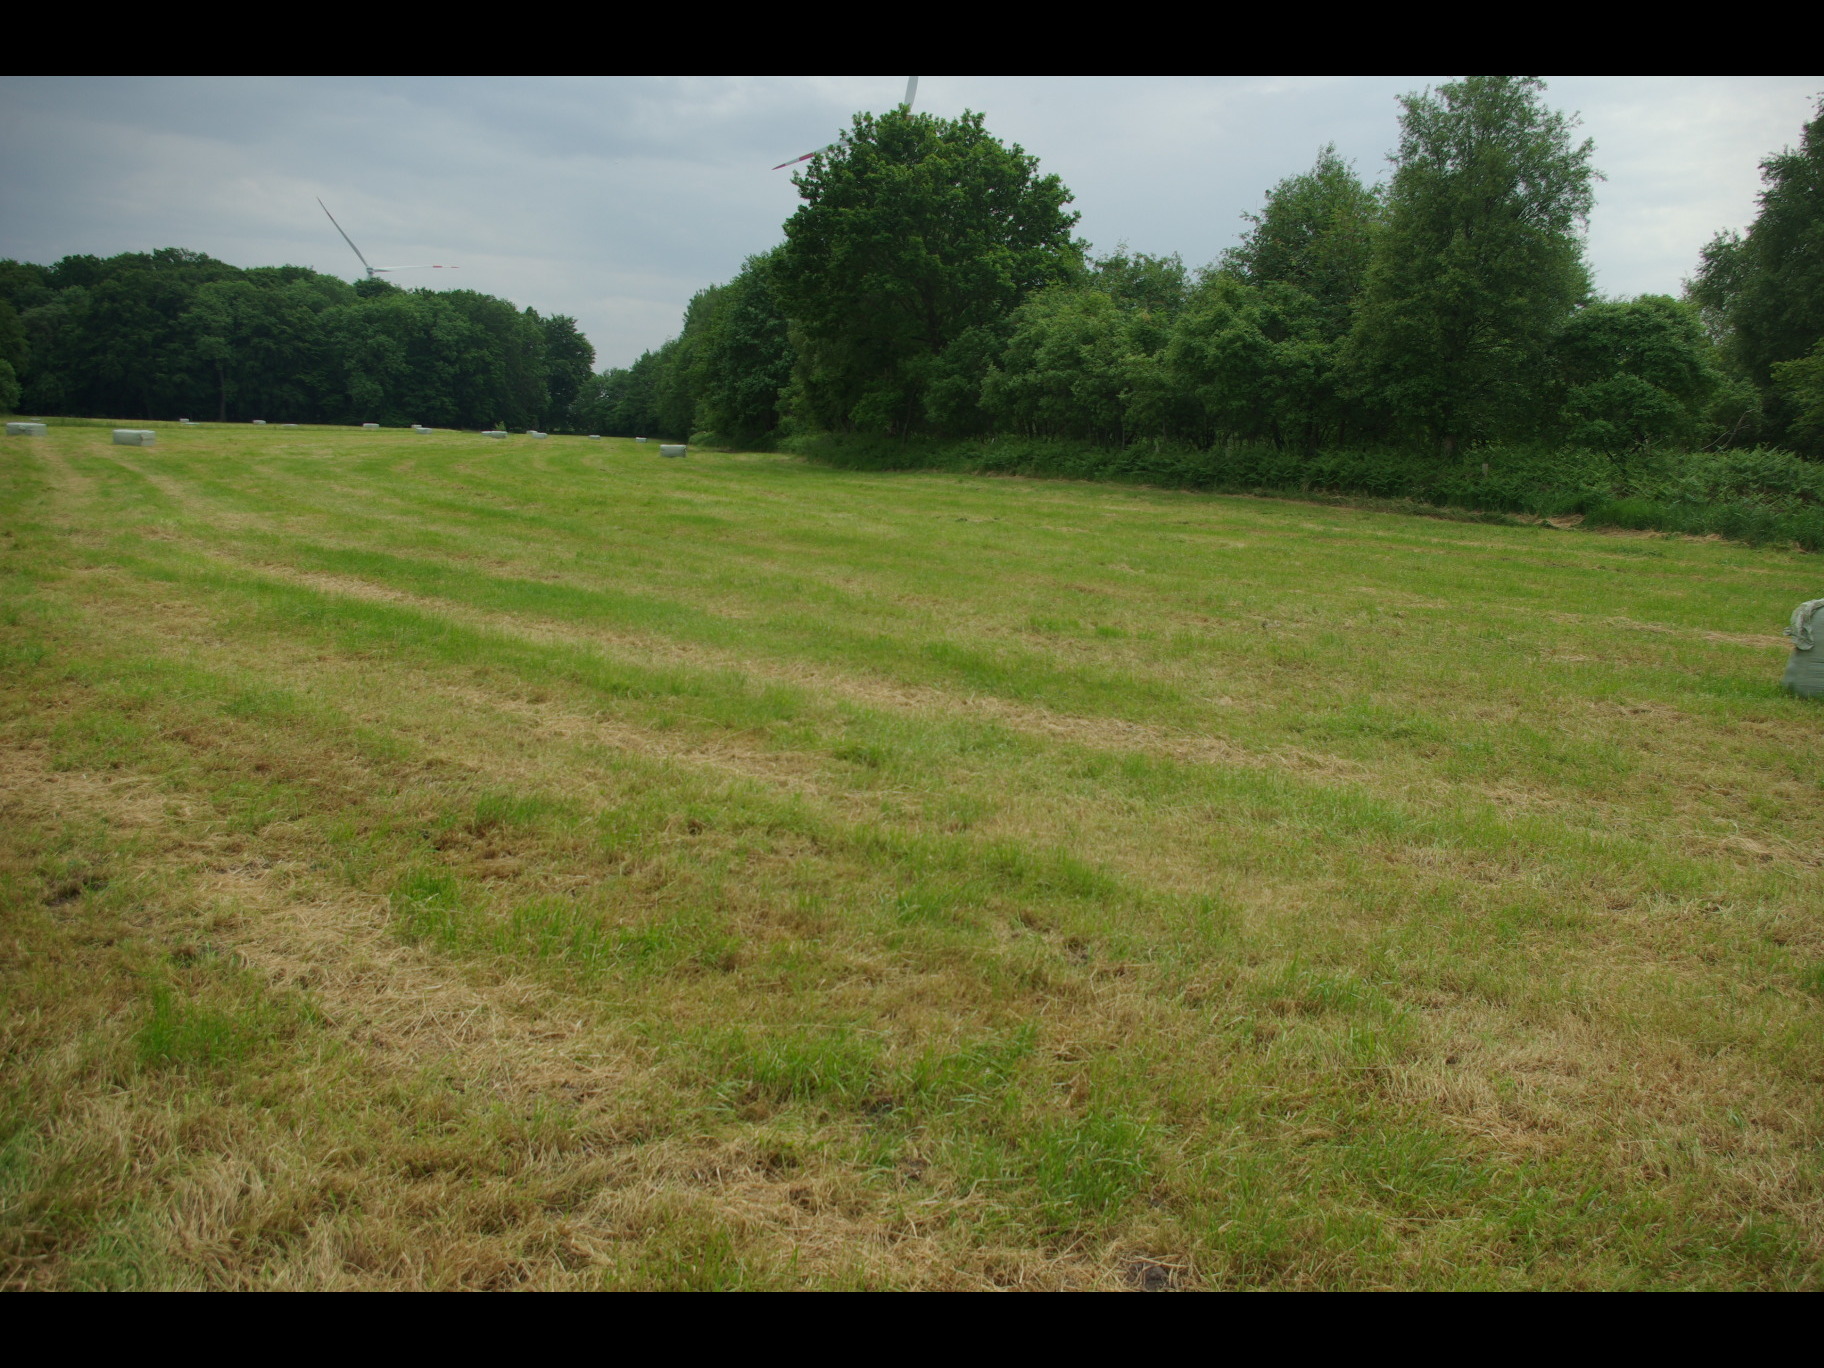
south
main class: Grassland
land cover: Grassland without tree/shrub cover
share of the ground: > 75 %
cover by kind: herbaceous plants 100 %
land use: Agriculture (excluding fallow land and kitchen gardens)
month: June
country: DE
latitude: 54.4083
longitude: 9.8922
